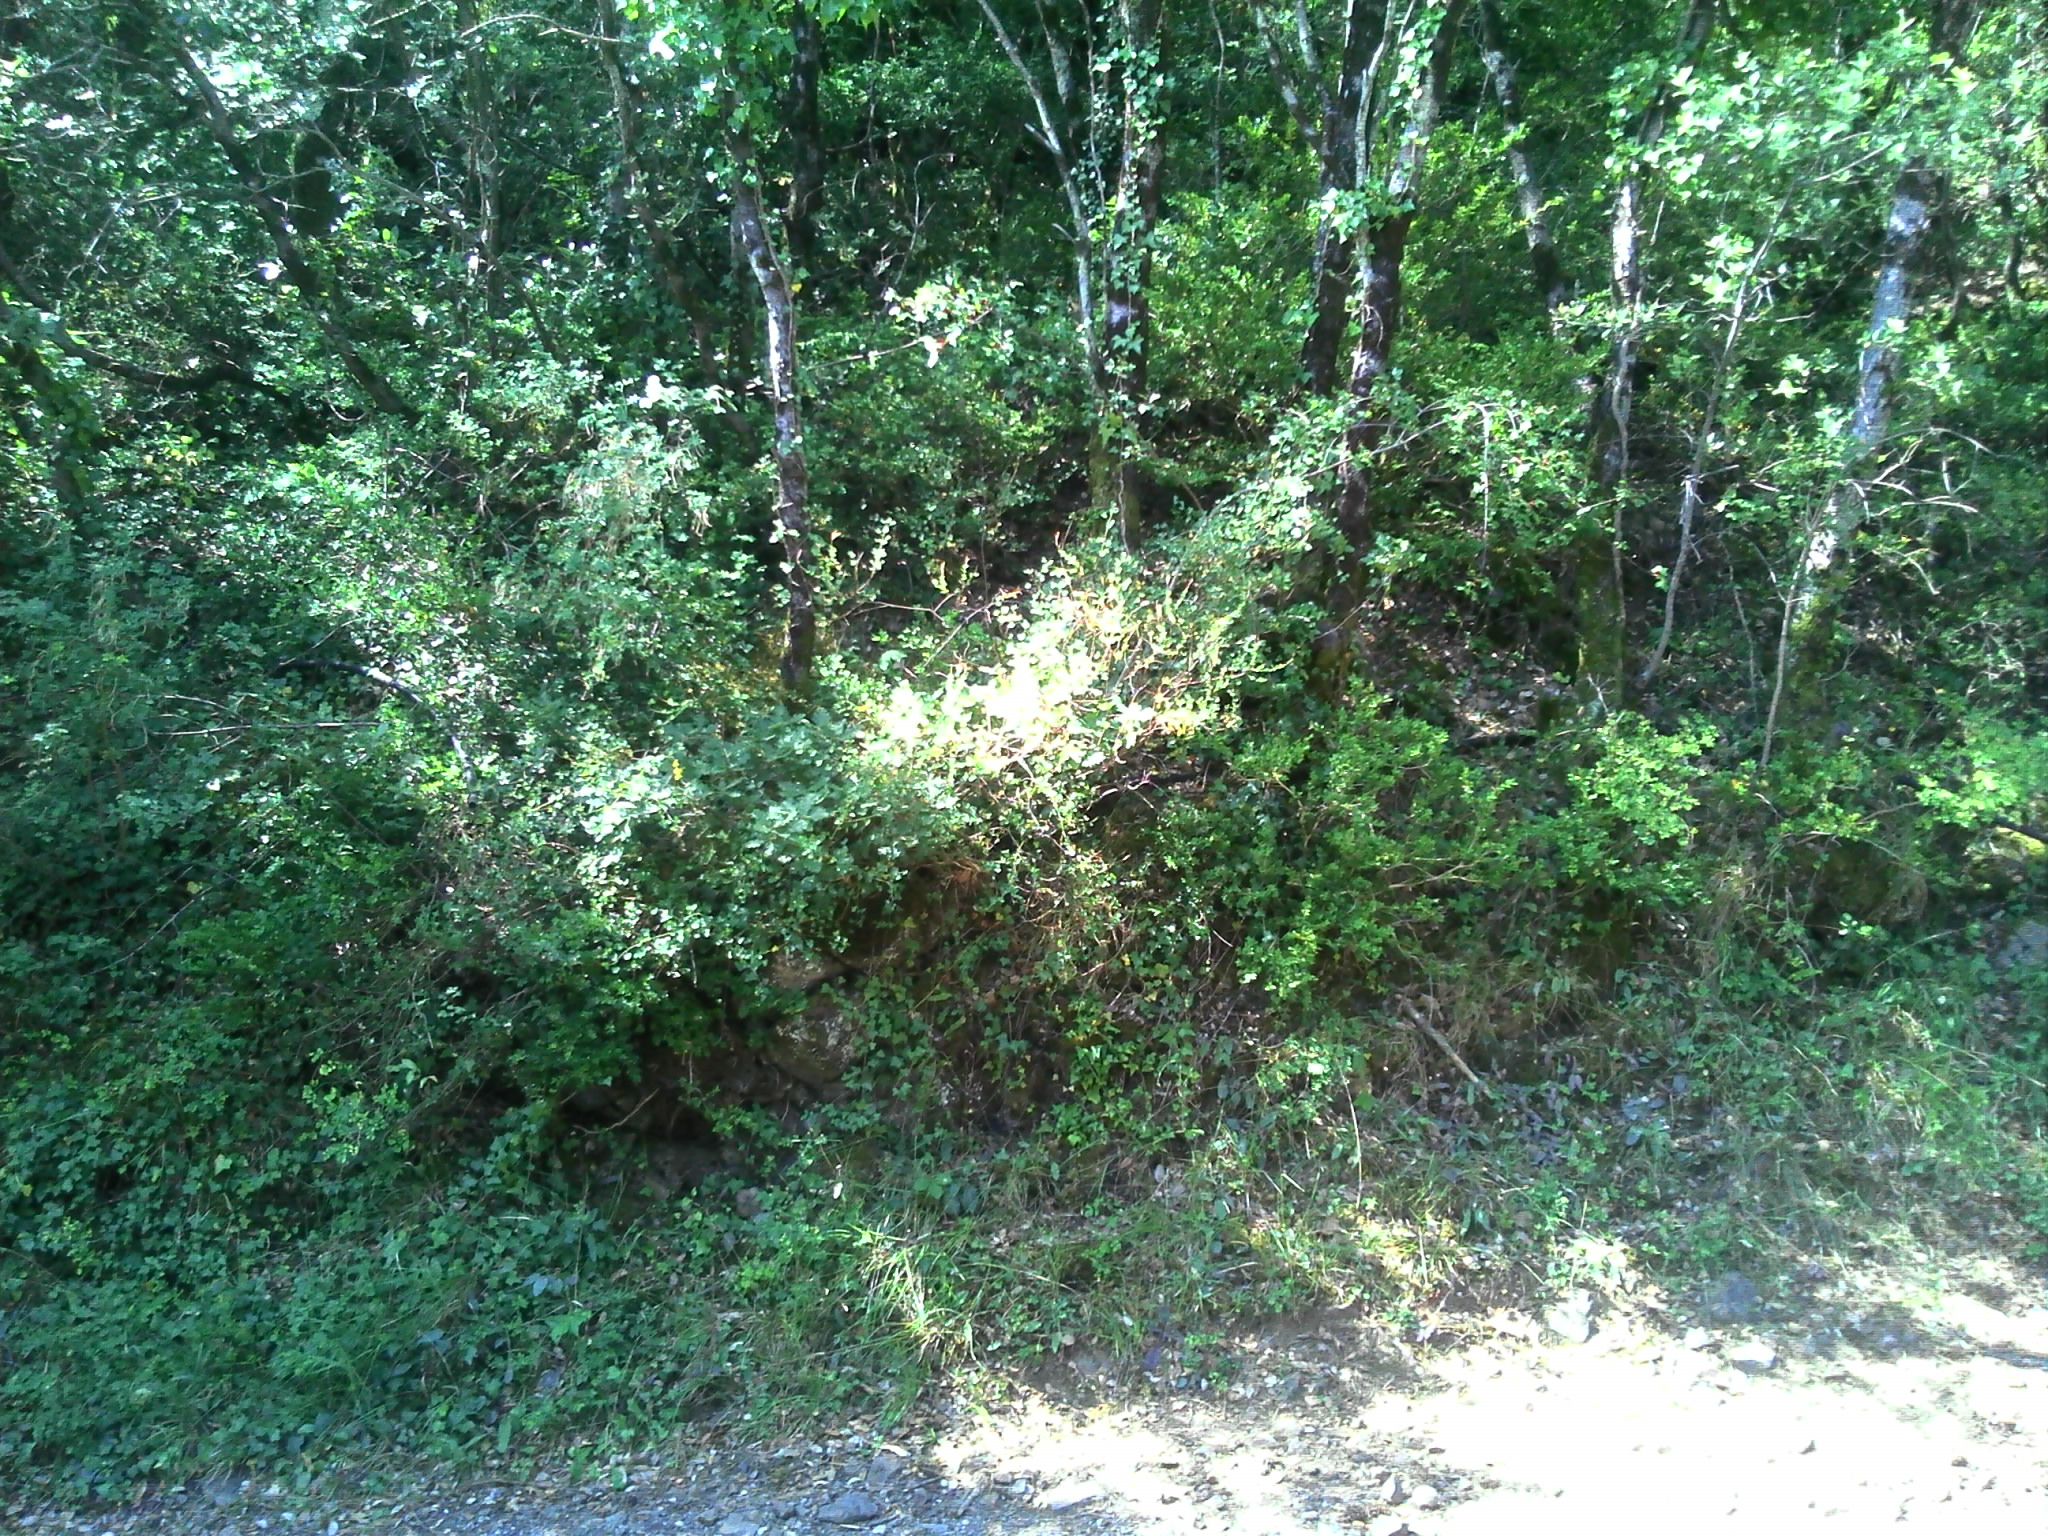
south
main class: Woodland
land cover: Broadleaved woodland
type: broadleaved evergreen forest
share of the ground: > 75 %
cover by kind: broadleaved forest trees 80 %, herbaceous plants 10 %, unconsolidated bare surface 10 %
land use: Forestry
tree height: > 5 m
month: October
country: FR
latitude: 44.0072
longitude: 3.5840
